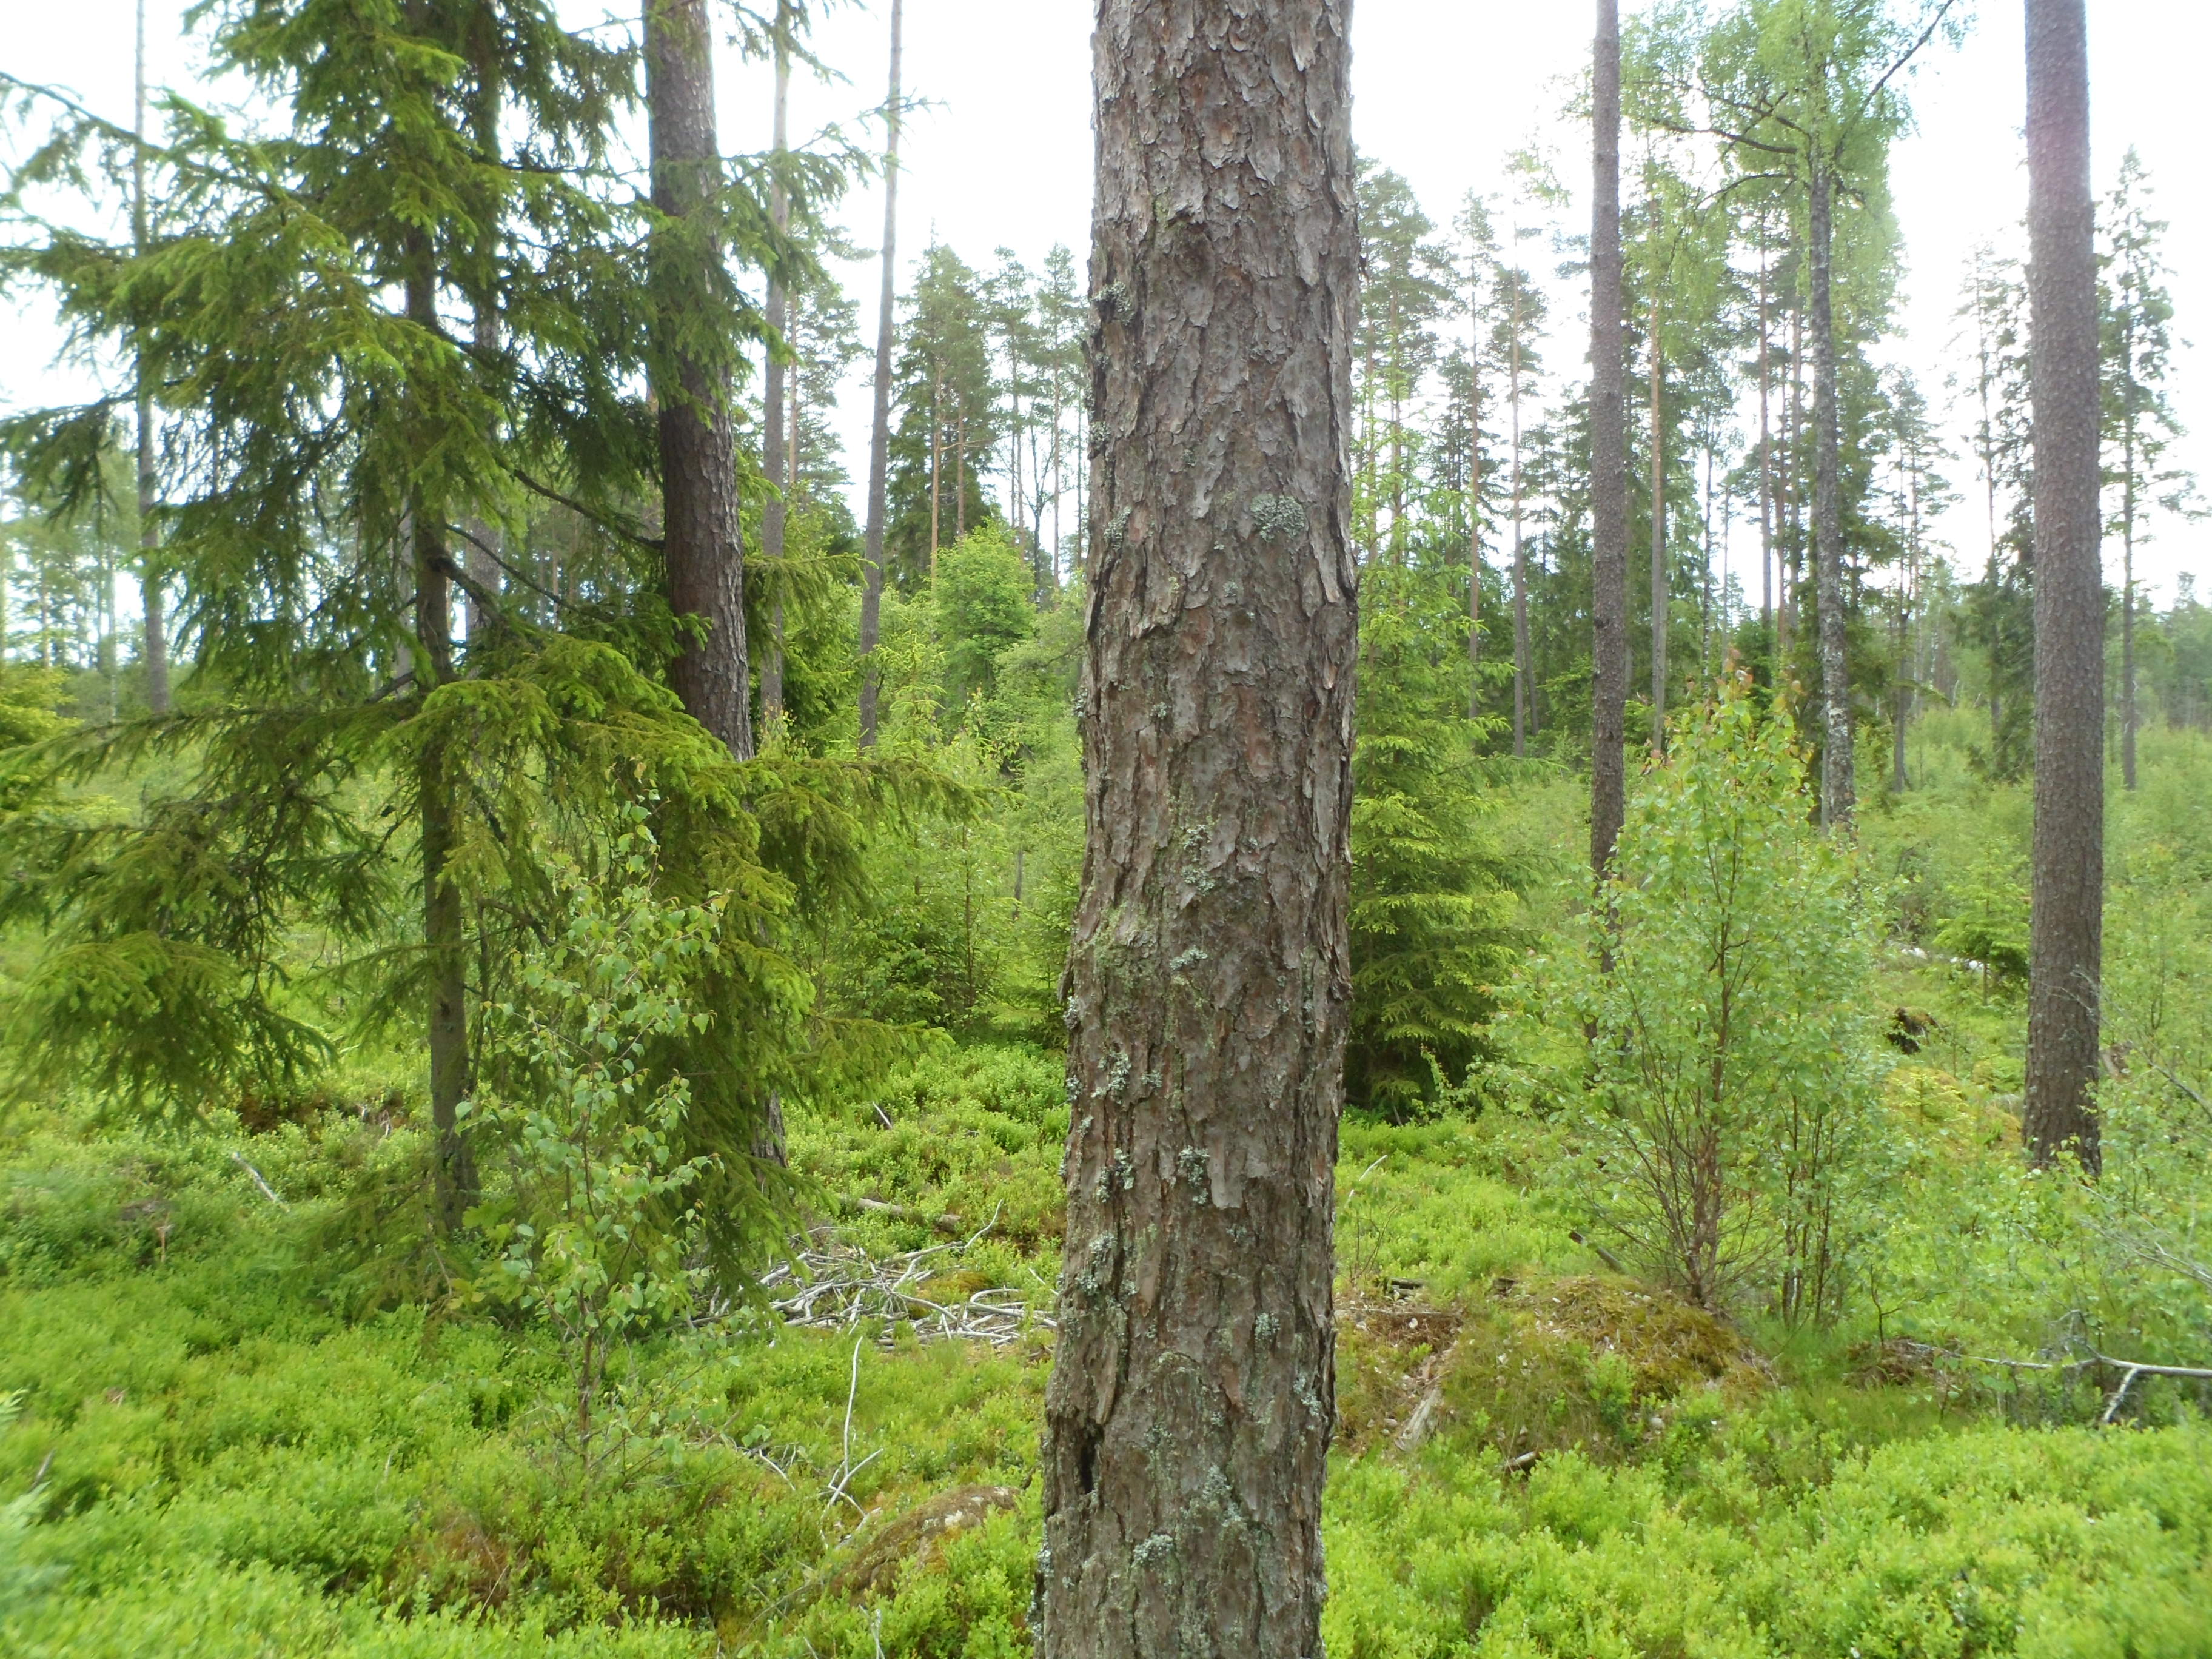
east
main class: Woodland
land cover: Pine dominated coniferous woodland
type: boreal forest
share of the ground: 25 - 50 %
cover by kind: shrubs 40 %, coniferous forest trees 30 %, lichens and mosses 20 %, broadleaved forest trees 5 %, herbaceous plants 5 %
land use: Forestry
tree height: > 5 m
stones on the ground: > 50 %
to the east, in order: Pine dominated coniferous woodland; Pine dominated mixed woodland; Pine dominated coniferous woodland; Grassland with sparse tree/shrub cover; Pine dominated coniferous woodland; Pine dominated mixed woodland
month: June
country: SE
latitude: 56.9255
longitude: 14.3177
